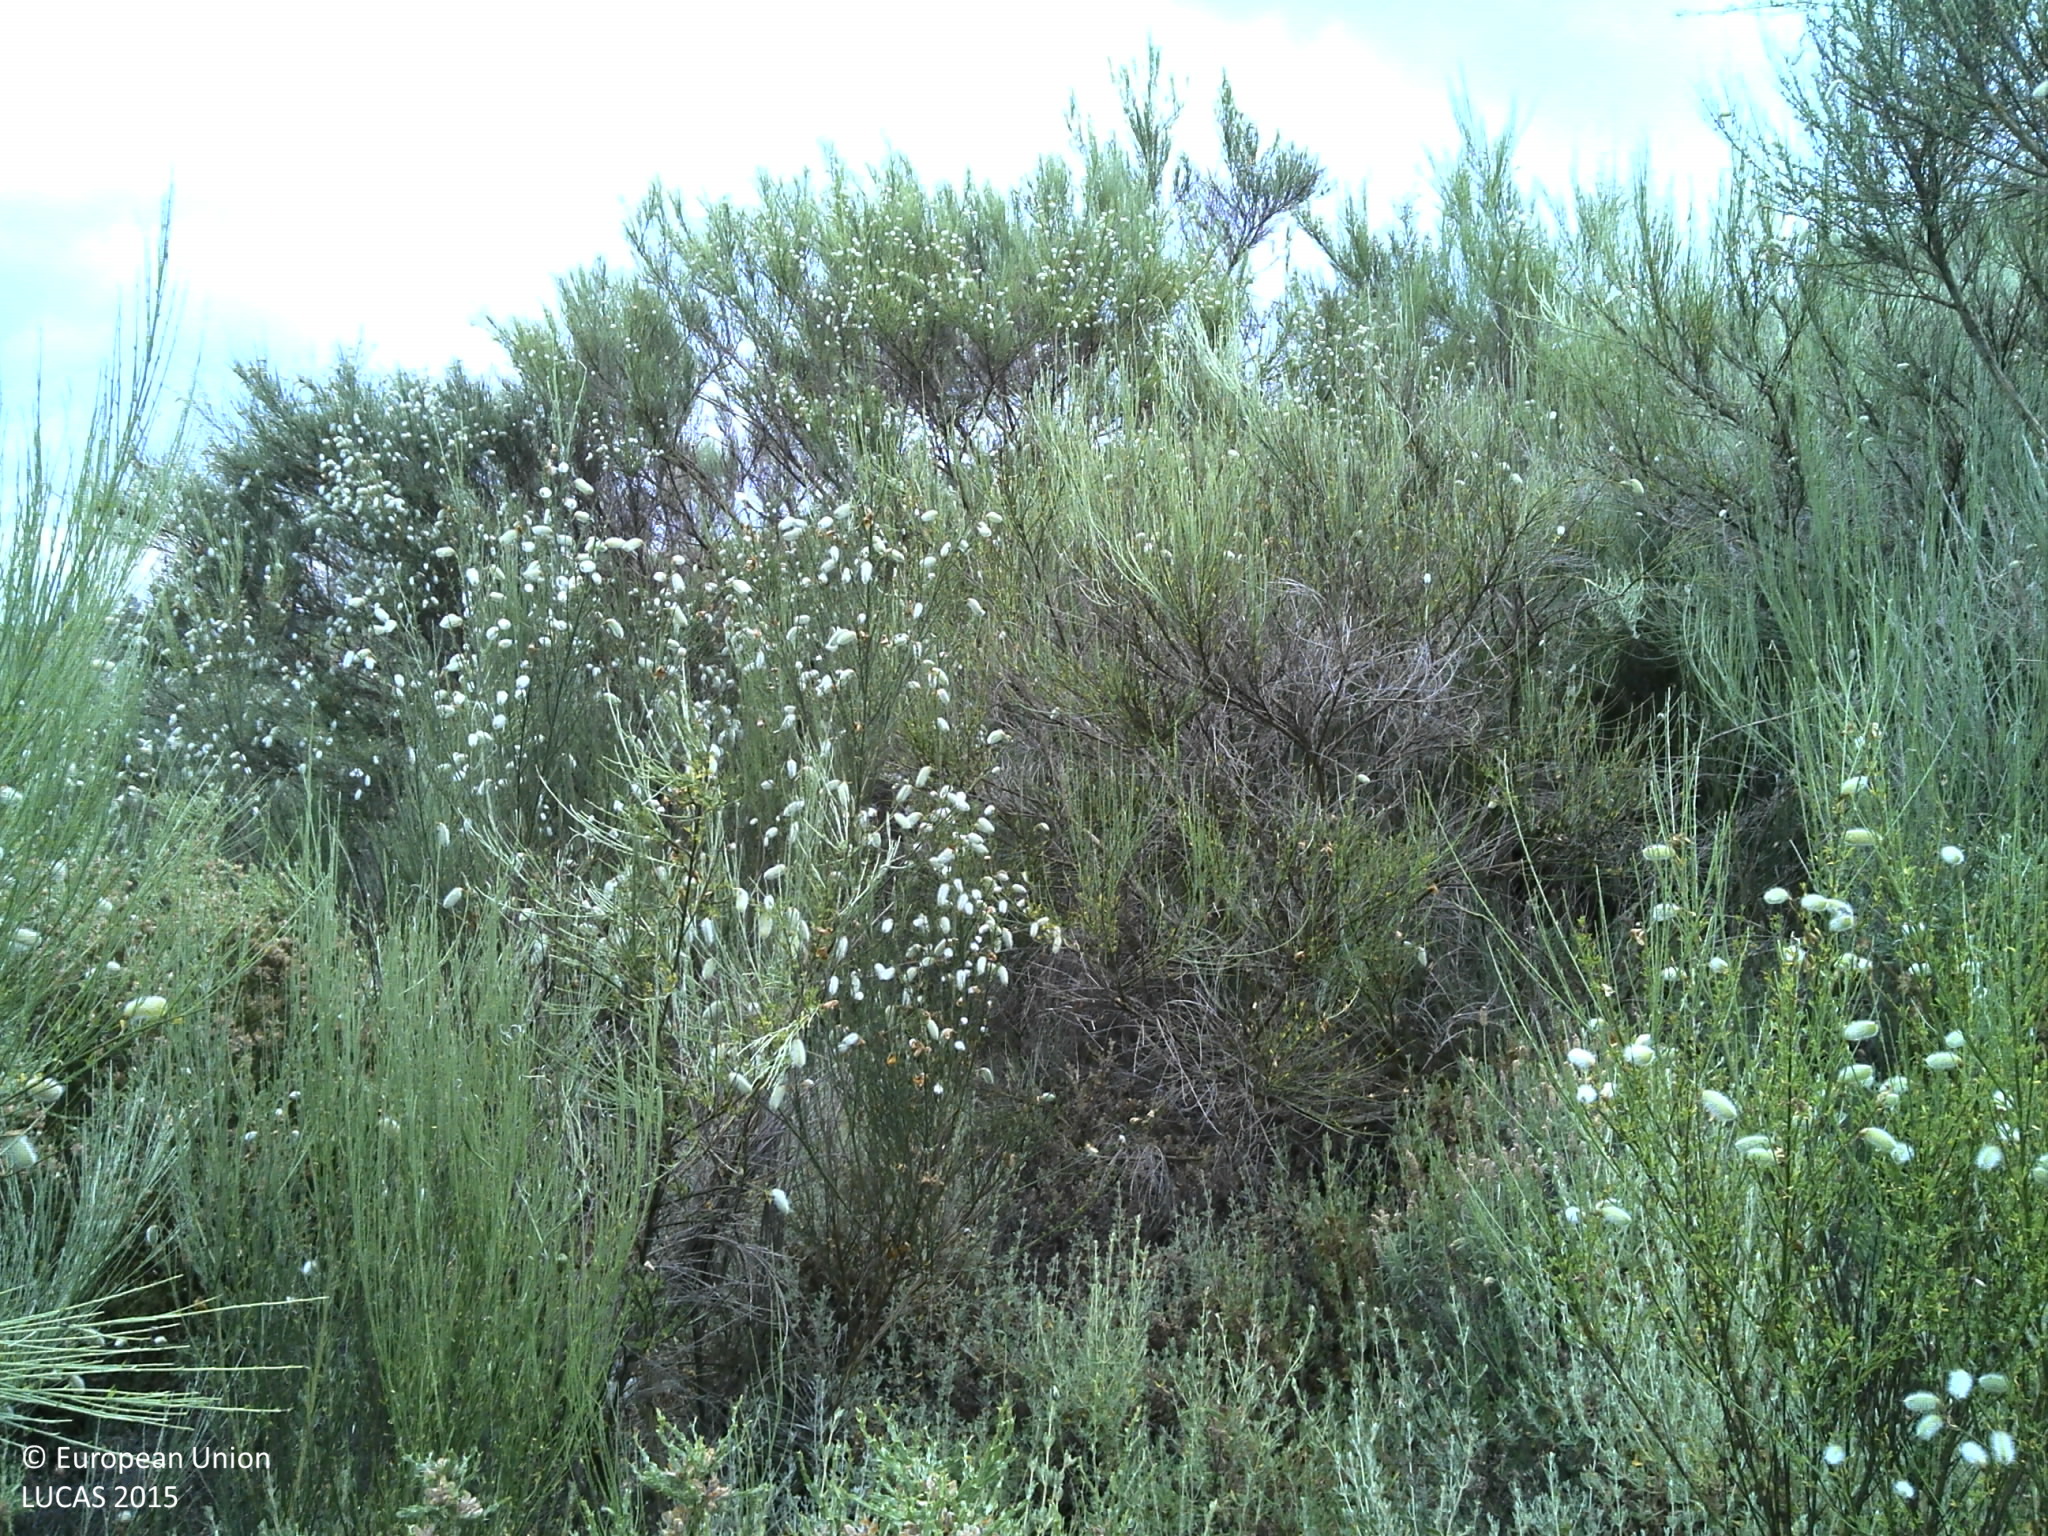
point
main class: Shrubland
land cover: Shrubland without tree cover
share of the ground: > 75 %
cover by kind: shrubs 90 %, unconsolidated bare surface 10 %
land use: Semi-natural and natural areas not in use
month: June
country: PT
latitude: 41.4751
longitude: -7.4533
